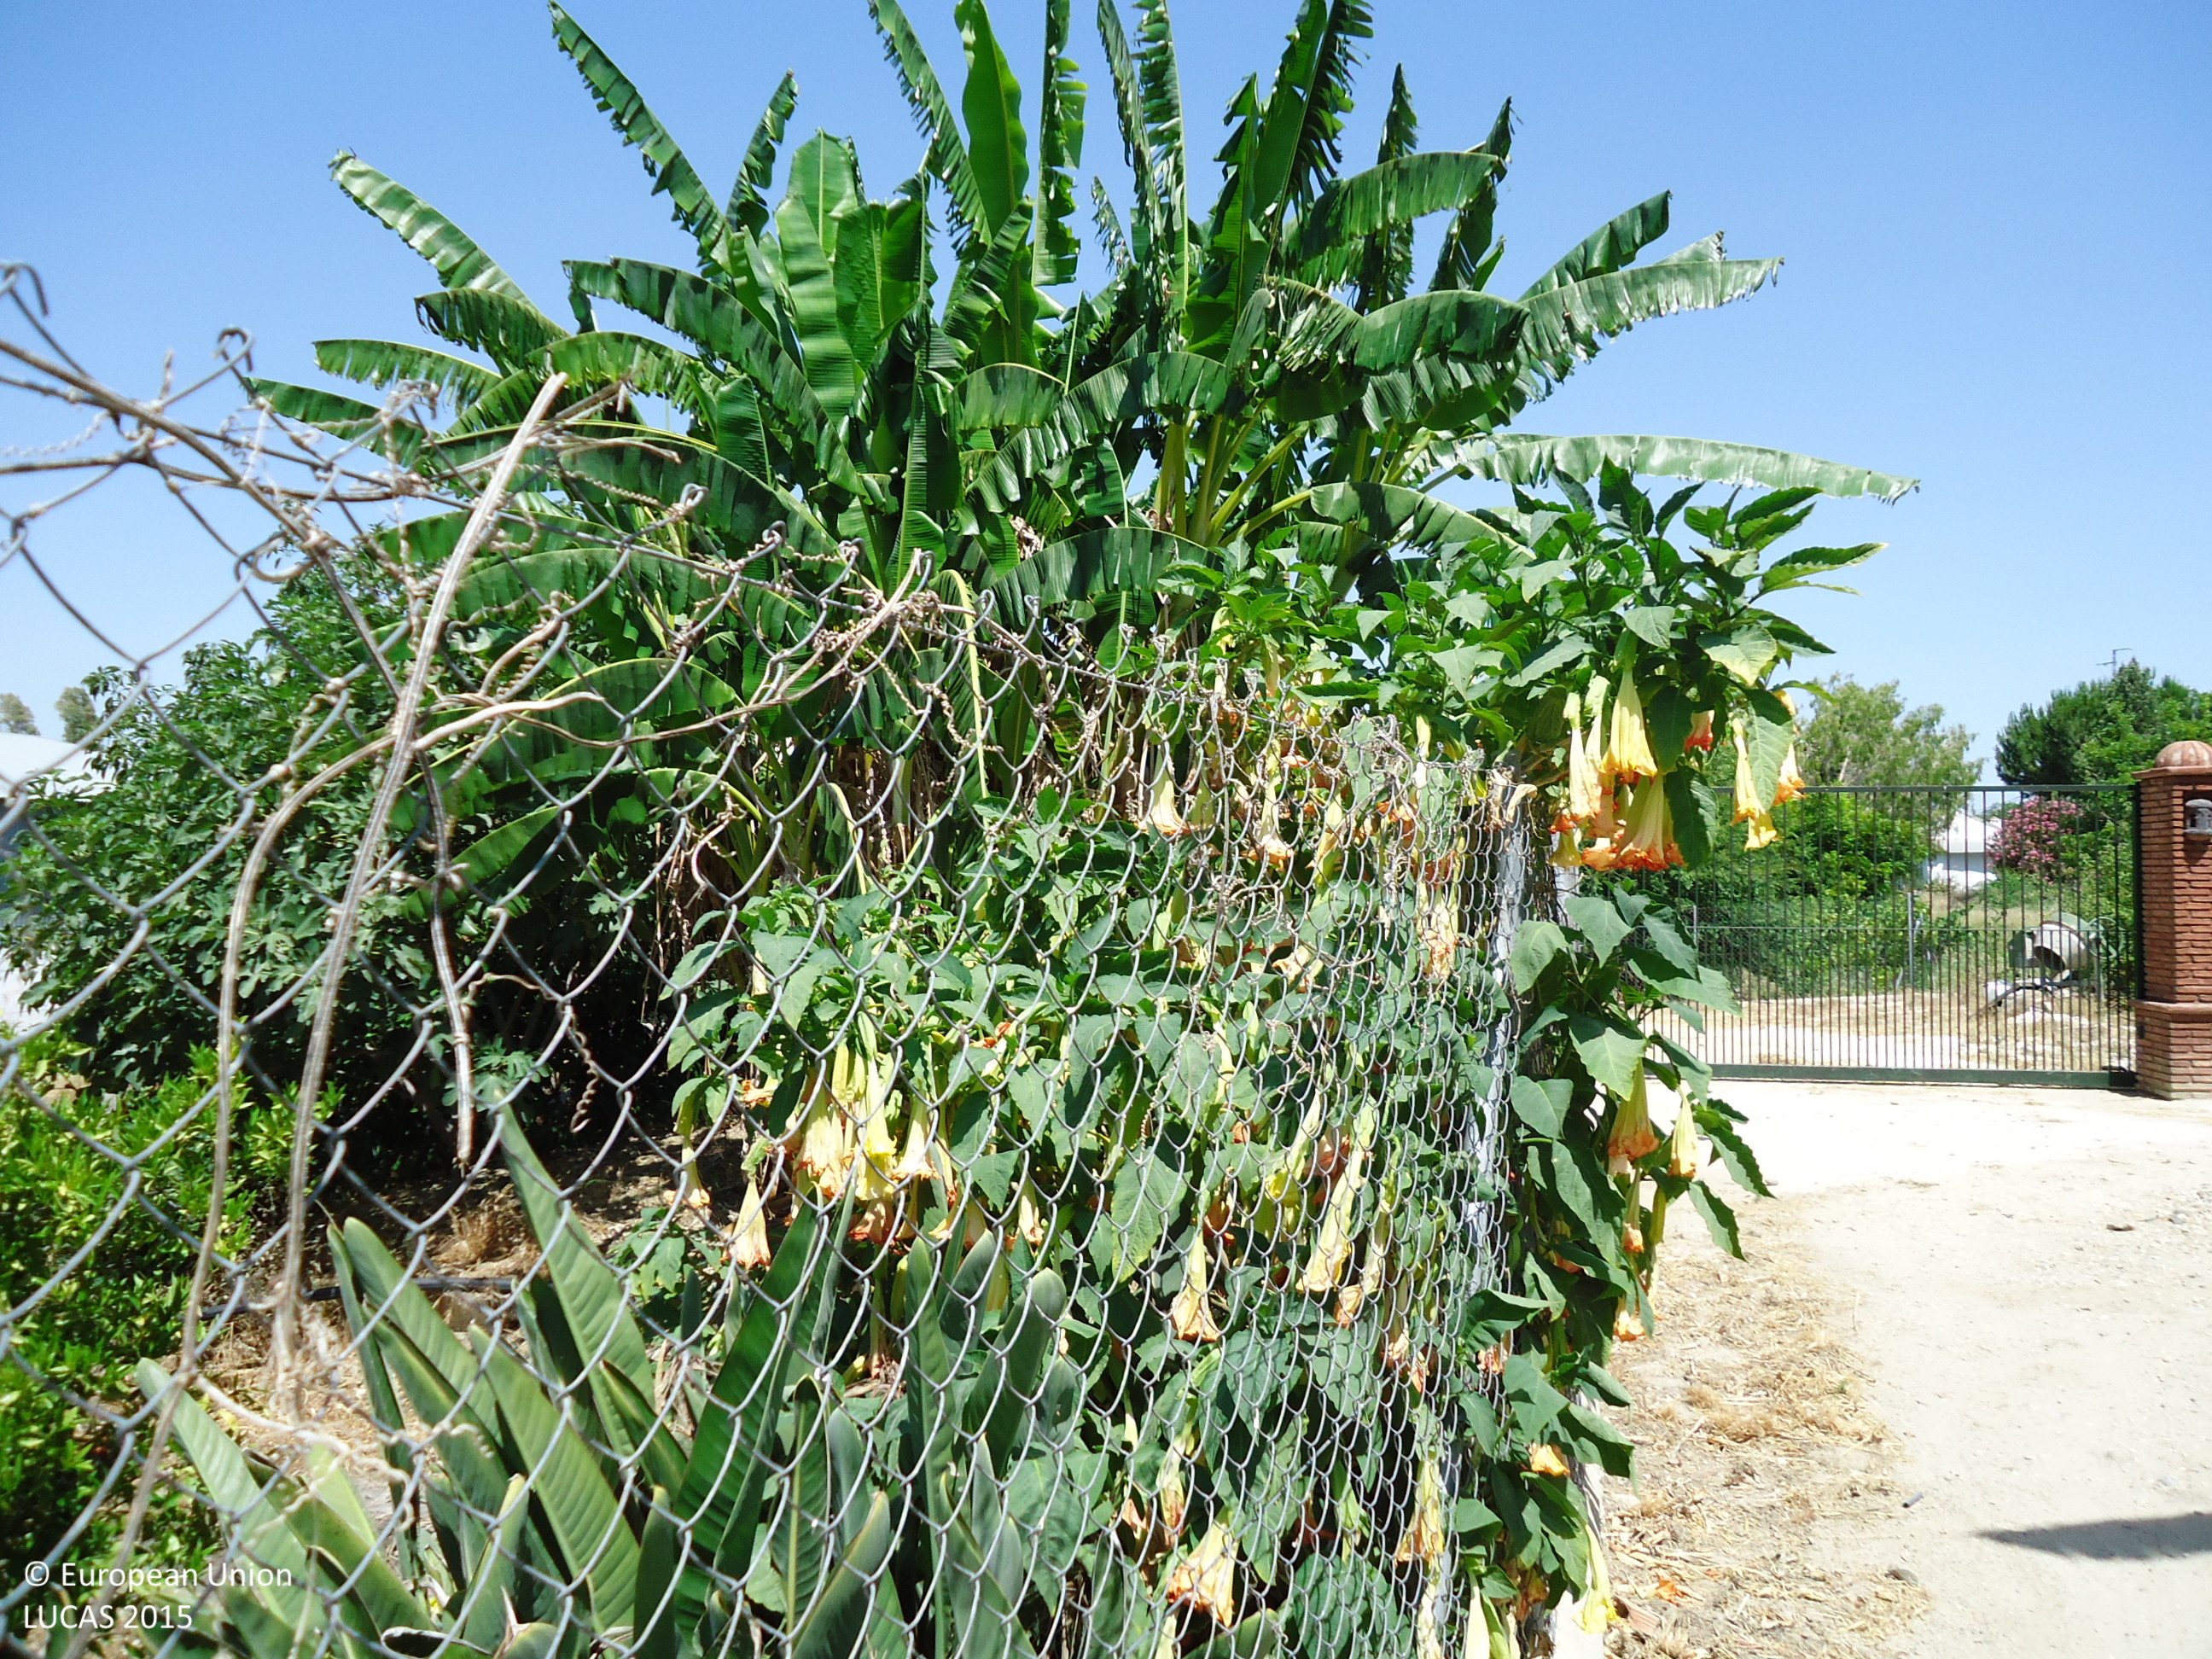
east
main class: Cropland
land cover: Oranges
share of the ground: 25 - 50 %
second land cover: Spontaneously vegetated surfaces
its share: > 75 %
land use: Agriculture (excluding fallow land and kitchen gardens)
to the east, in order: Oranges; Spontaneously vegetated surfaces; Artificial constructions in urban areas; Tracks; Fences; Vineyards; Broadleaved woodland; Artificial constructions in urban areas; Nuts trees; Tracks; Oranges; Tracks; Ditches and canals; Spontaneously vegetated surfaces; Grass margins; Oranges
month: June
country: ES
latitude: 36.6998
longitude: -4.7571
